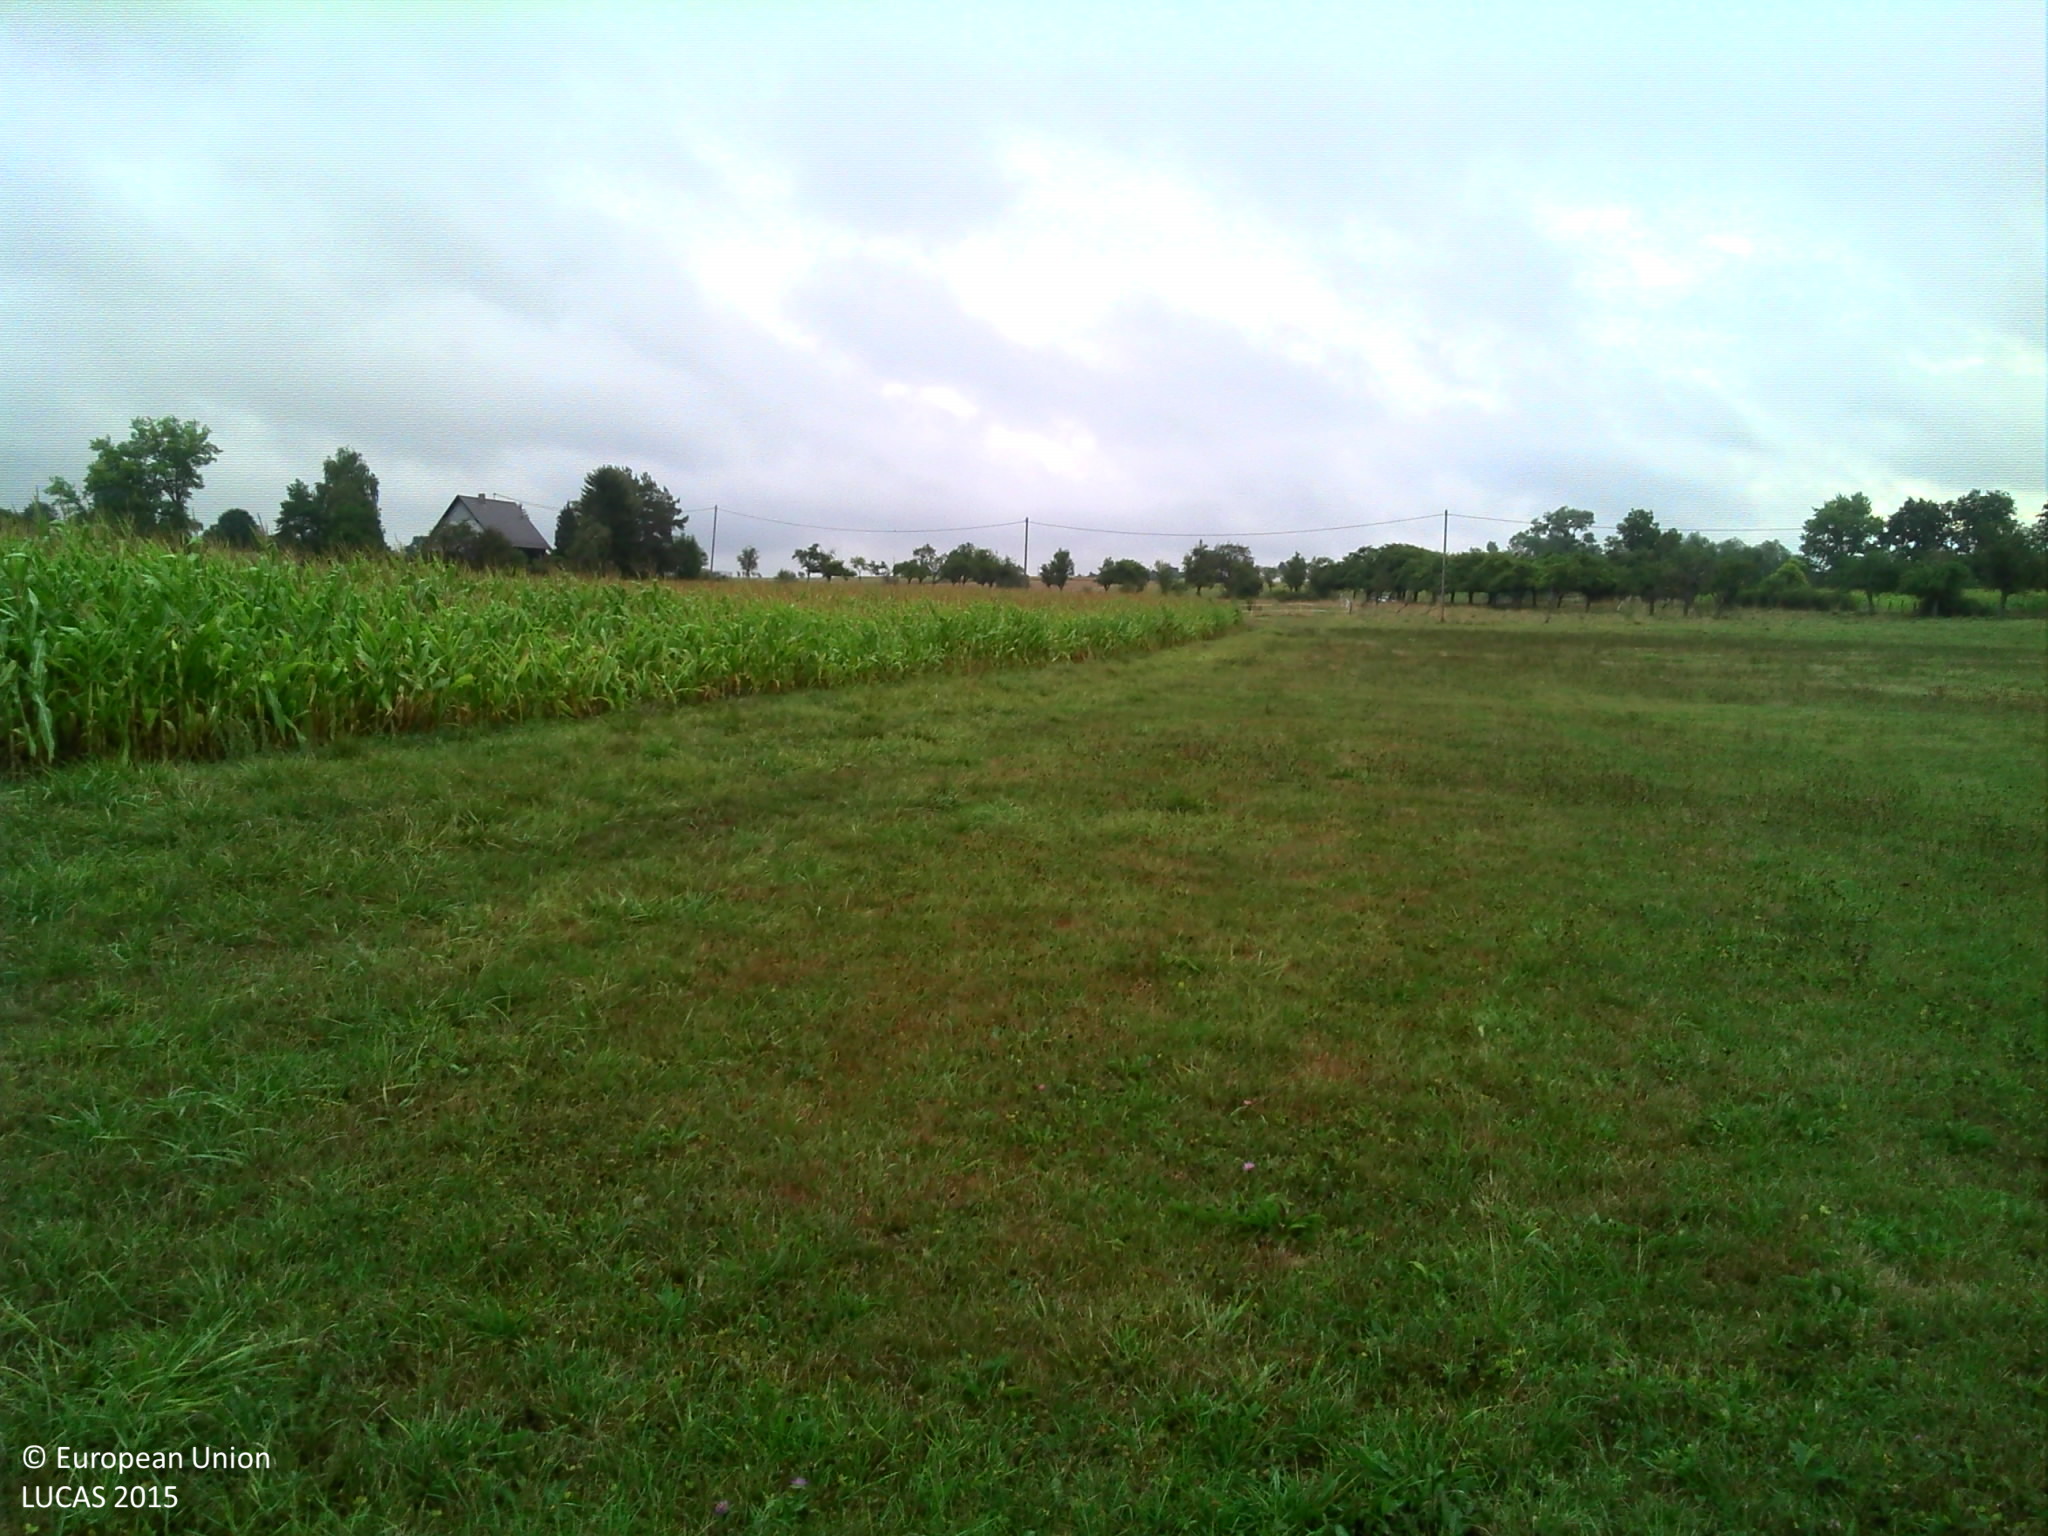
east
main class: Grassland
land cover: Grassland without tree/shrub cover
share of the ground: > 75 %
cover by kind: herbaceous plants 100 %
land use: Agriculture (excluding fallow land and kitchen gardens)
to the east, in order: Grassland without tree/shrub cover; Electric lines; Grassland without tree/shrub cover; Fences; Grassland with sparse tree/shrub cover; Single bushes/trees
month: August
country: FR
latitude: 48.8081
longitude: 7.5361
